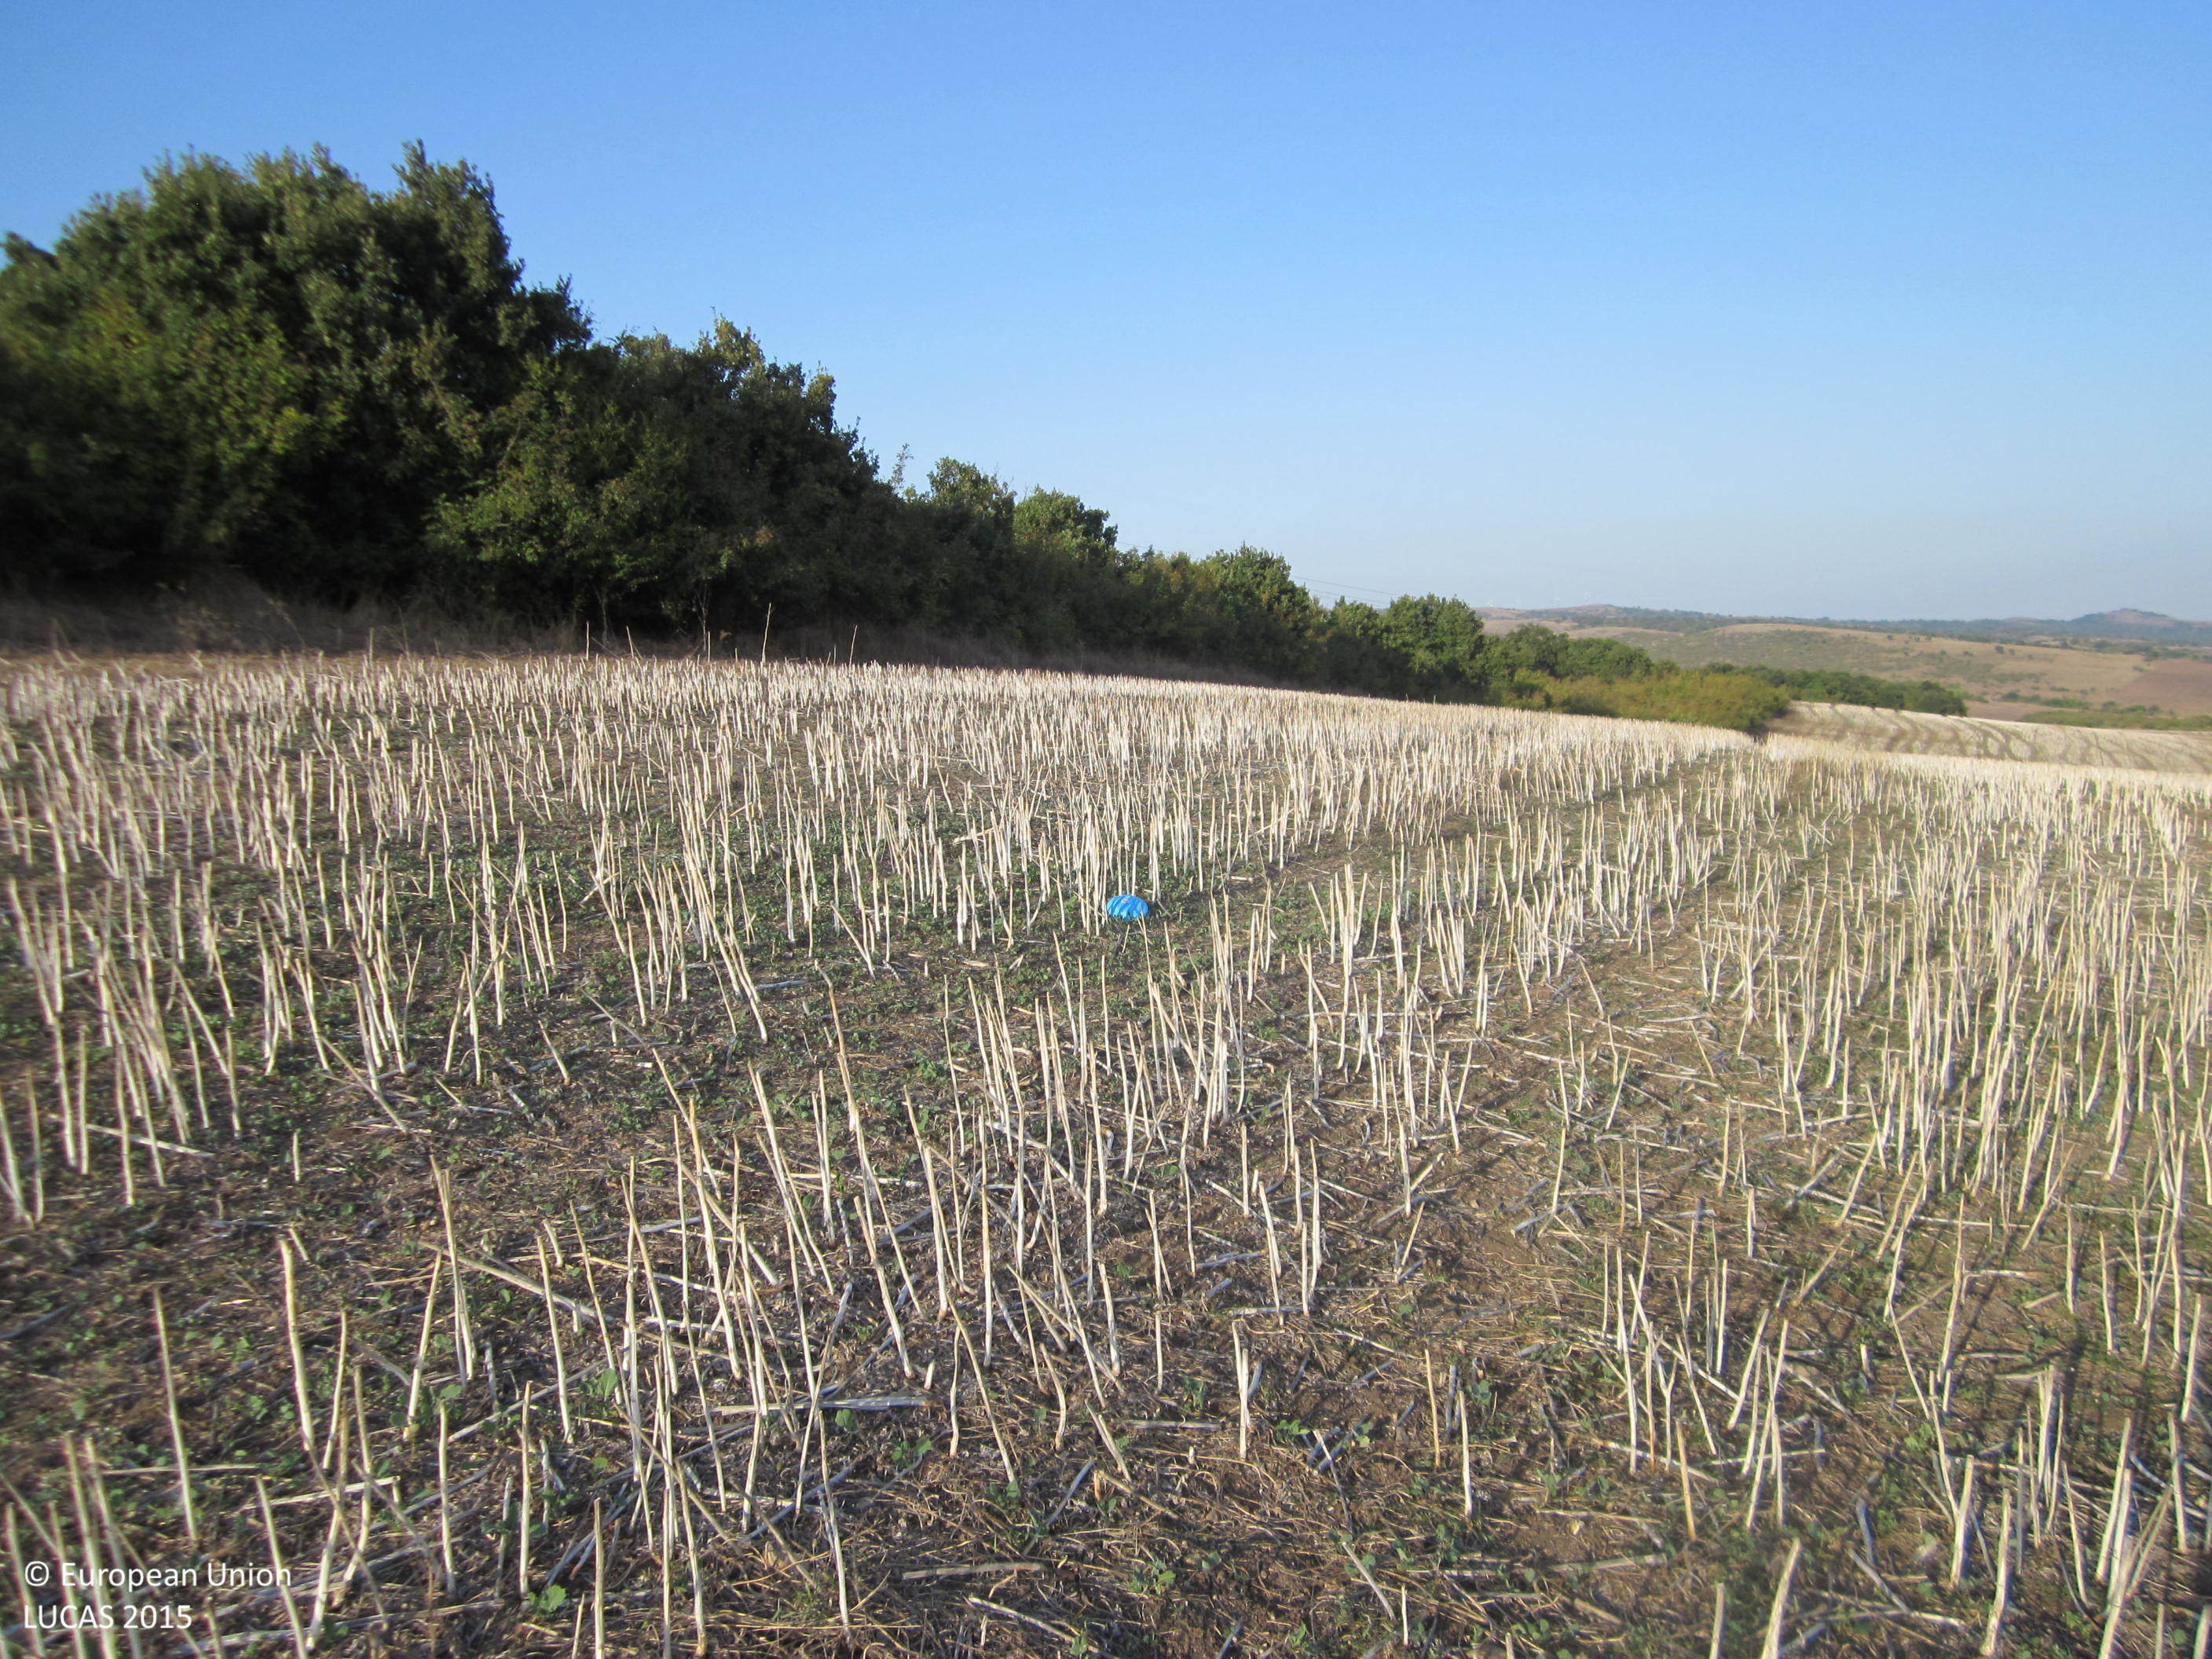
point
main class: Cropland
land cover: Rape and turnip rape
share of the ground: 10 - 25 %
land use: Agriculture (excluding fallow land and kitchen gardens)
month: September
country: BG
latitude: 42.6538
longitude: 27.3524
